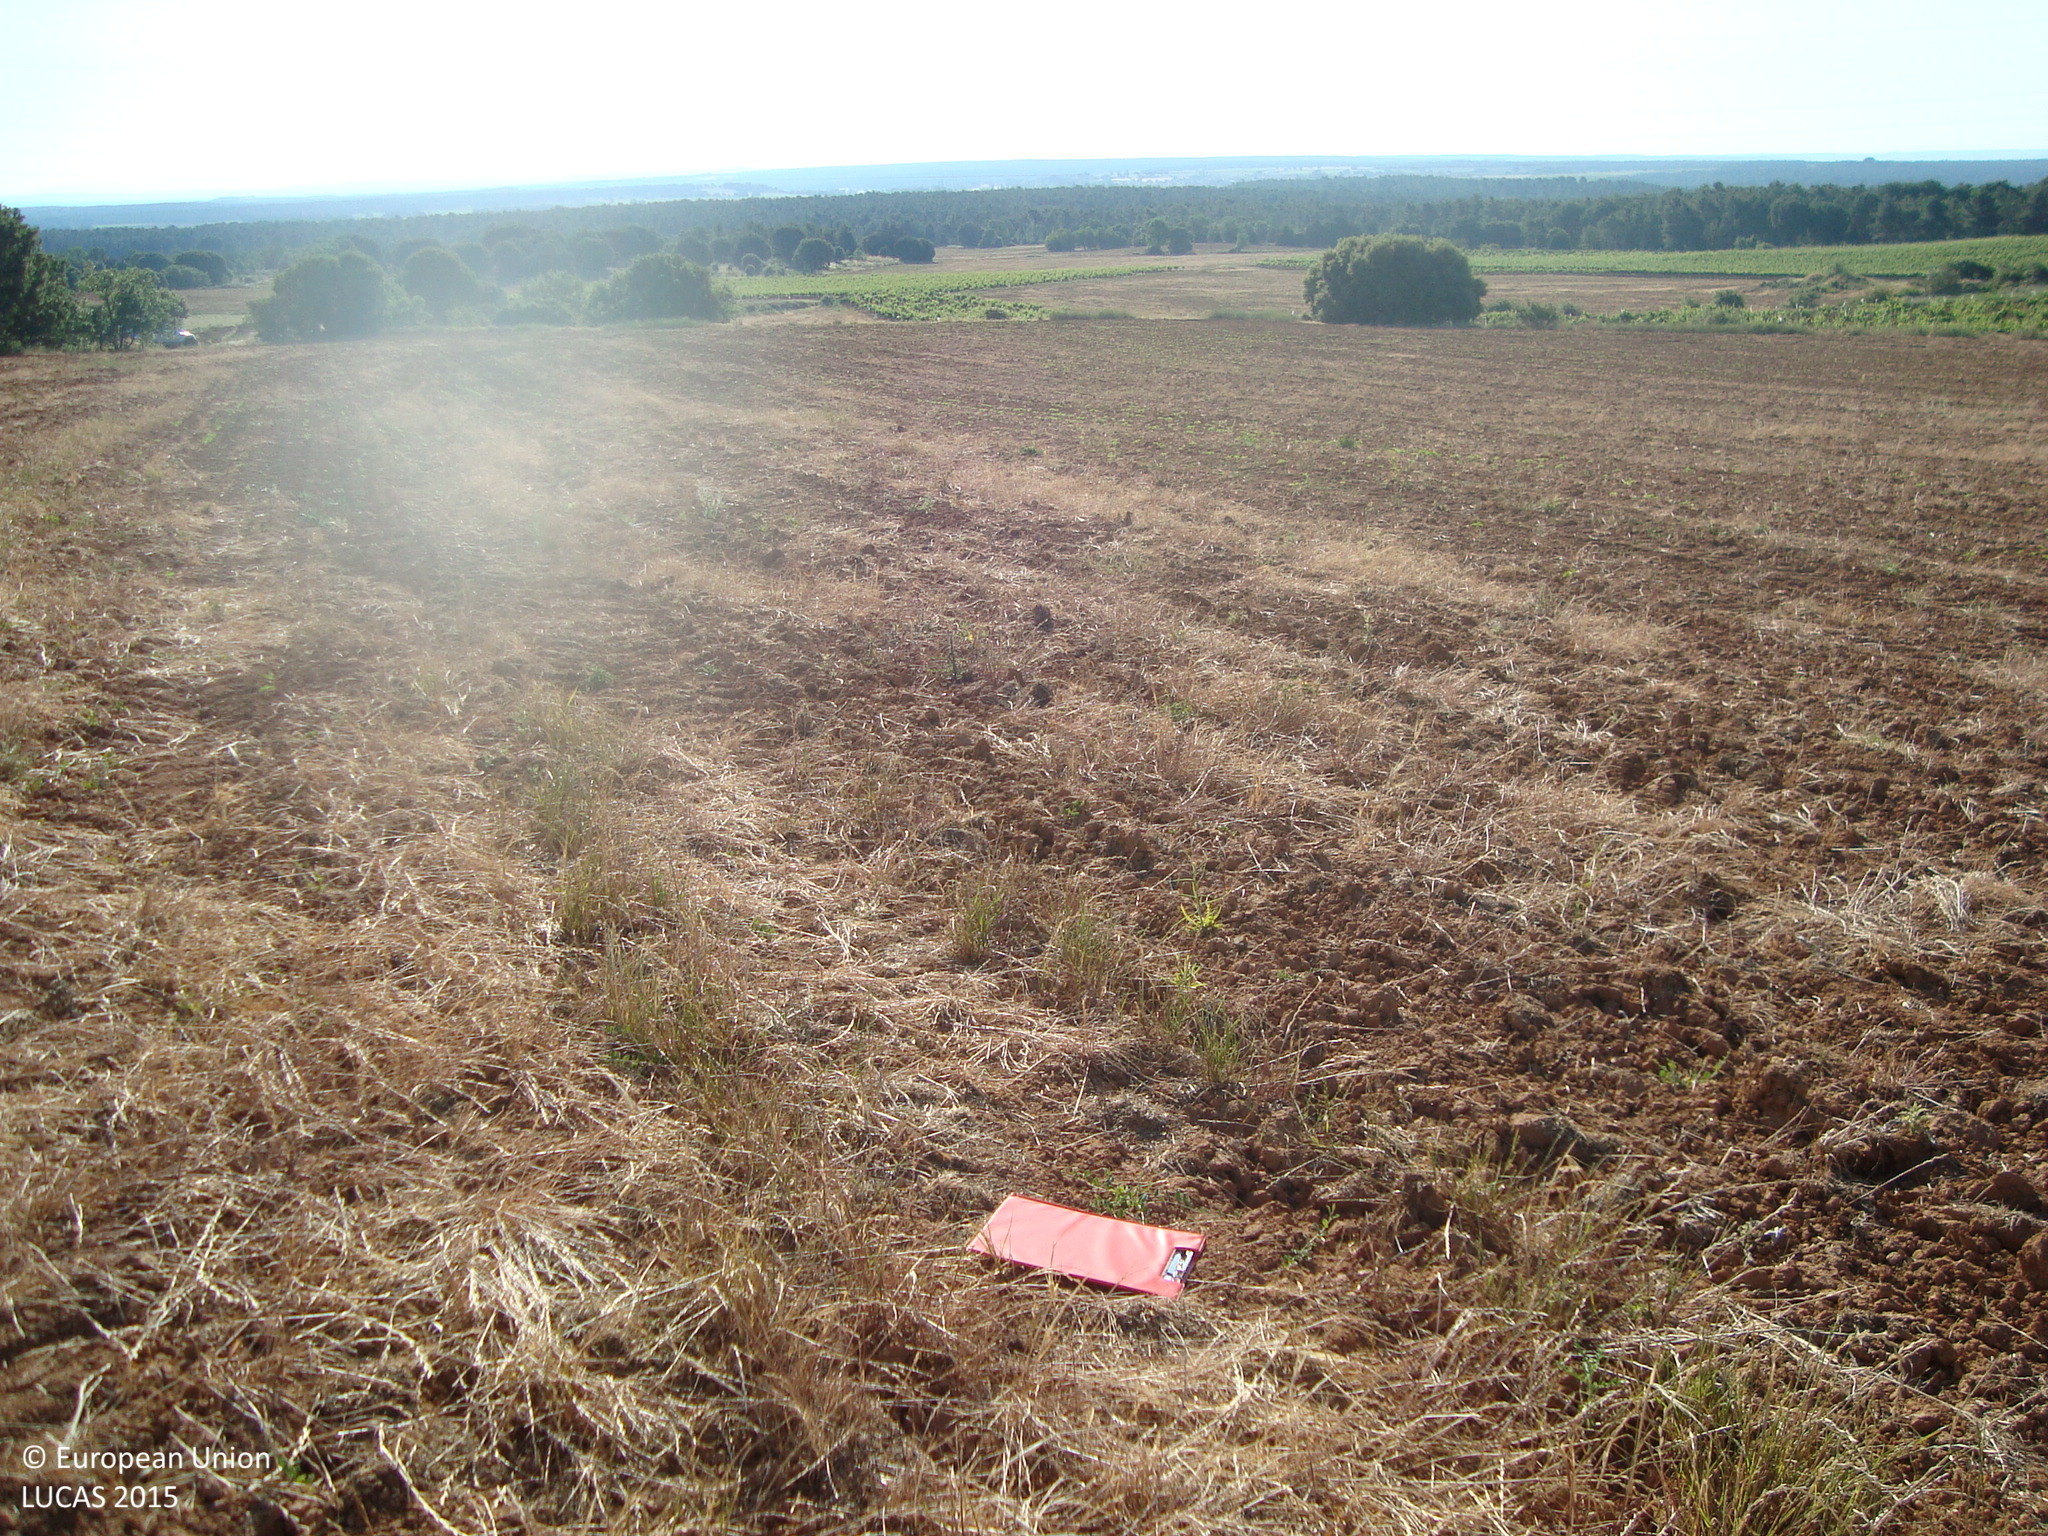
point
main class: Cropland
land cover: Sunflower
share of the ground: < 10 %
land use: Agriculture (excluding fallow land and kitchen gardens)
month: June
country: ES
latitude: 41.7397
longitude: -3.6765
